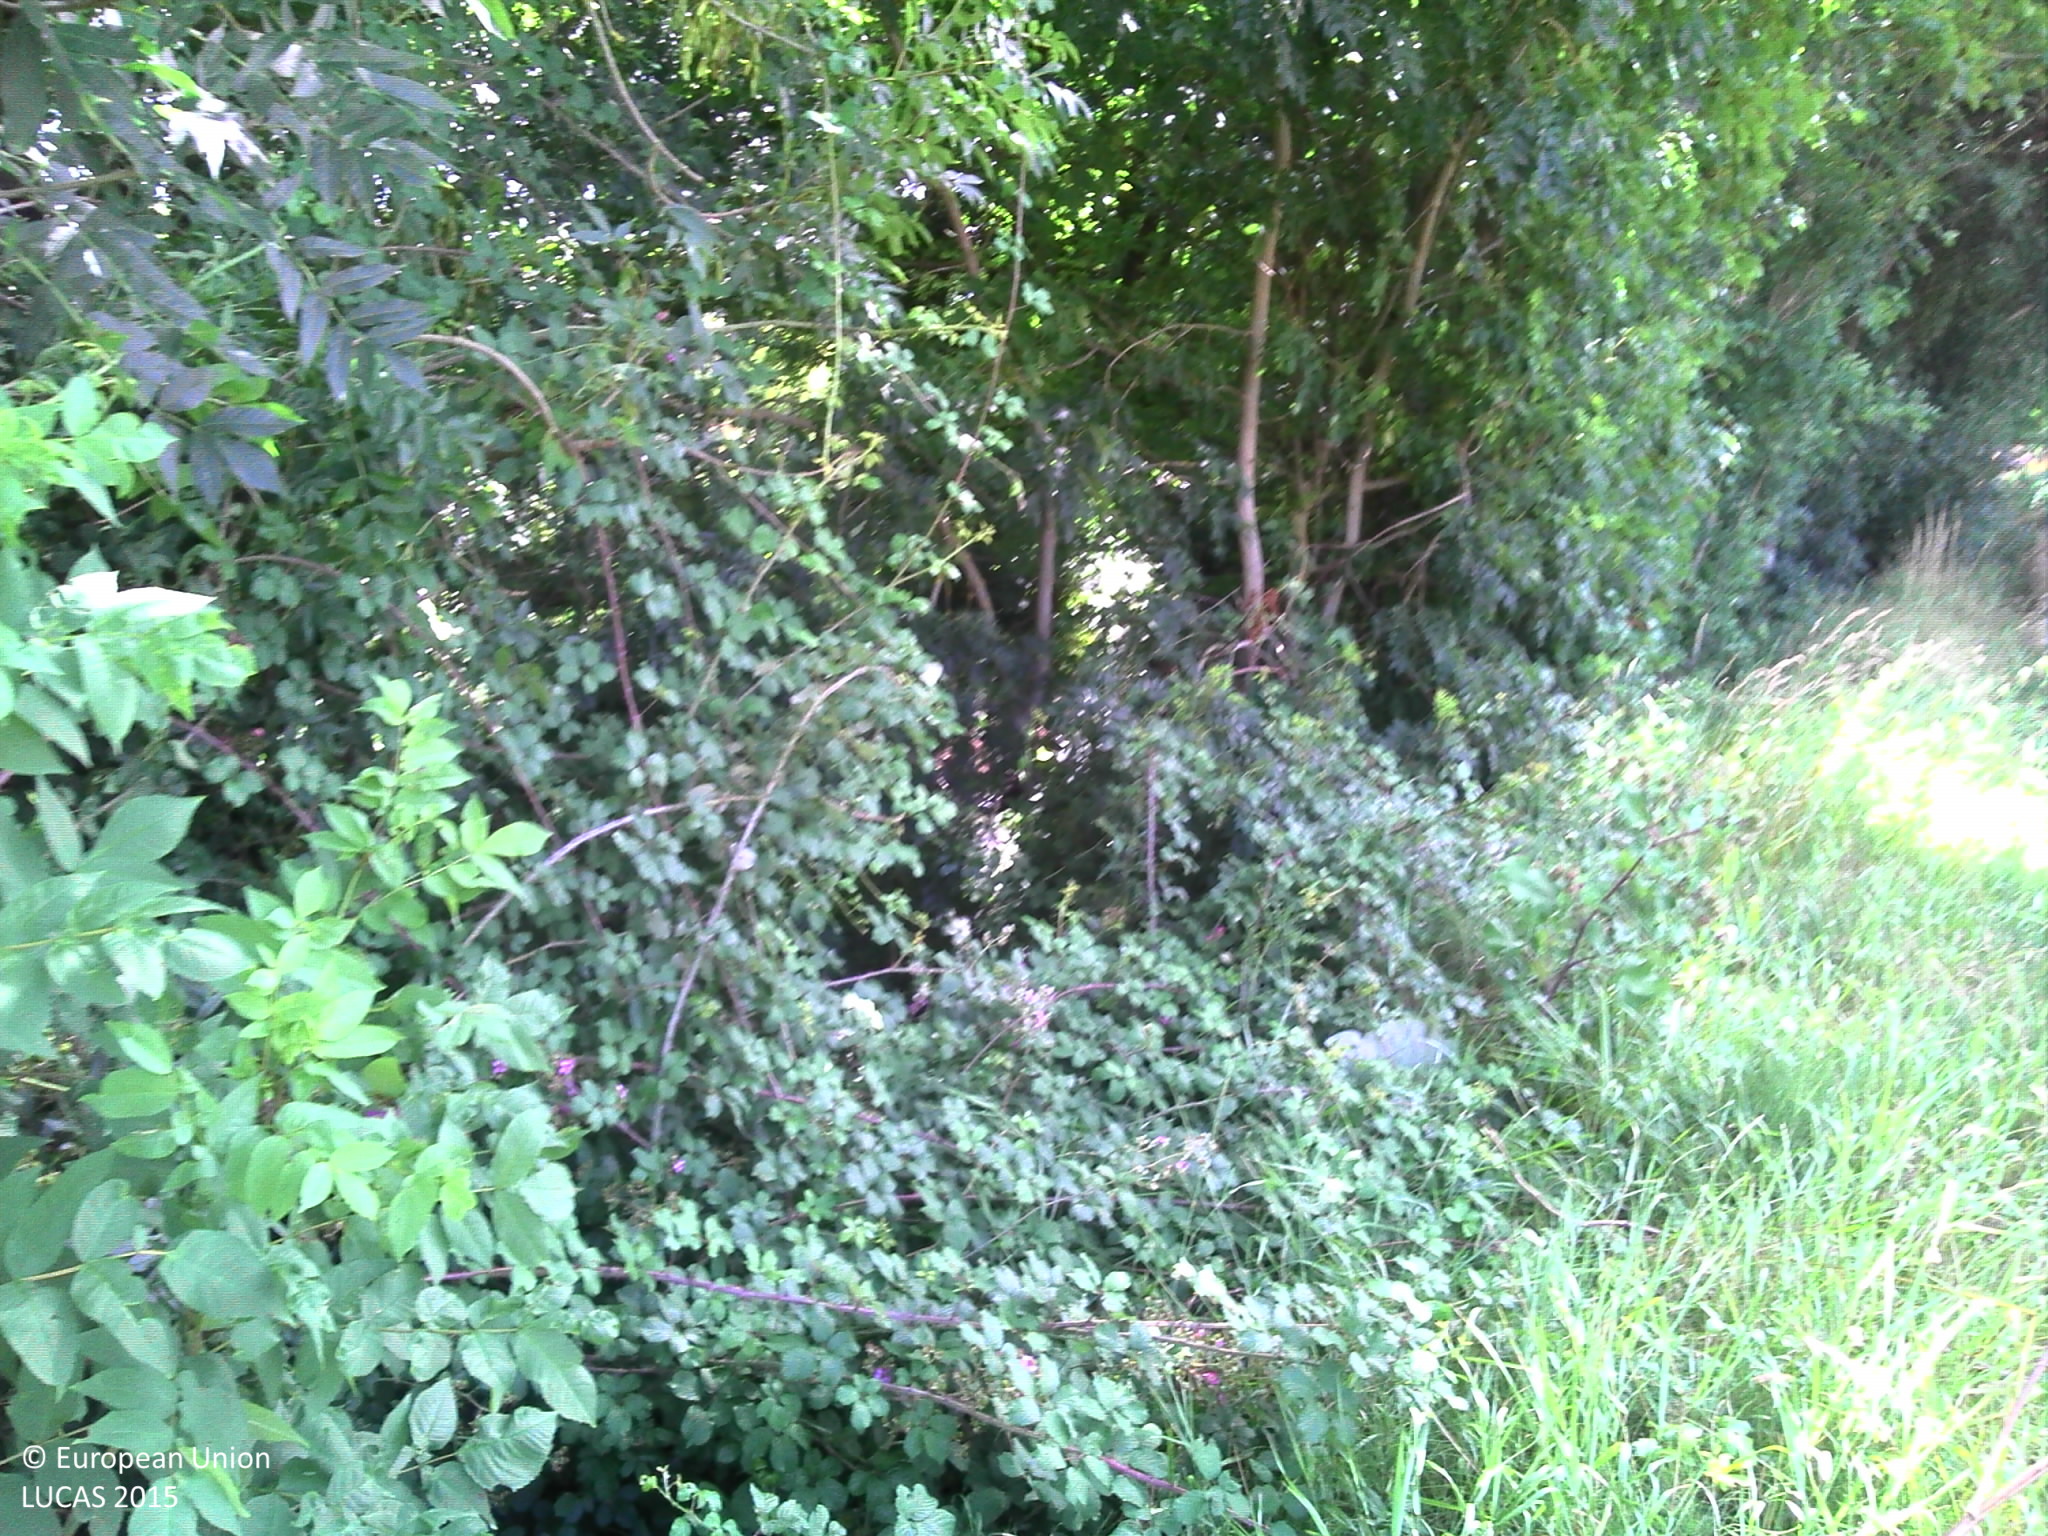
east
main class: Woodland
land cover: Broadleaved woodland
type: mesophytic deciduous forest
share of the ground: > 75 %
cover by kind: broadleaved forest trees 90 %, herbaceous plants 10 %
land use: Semi-natural and natural areas not in use
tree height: < 5 m
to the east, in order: Broadleaved woodland; Inland fresh water bodies; Broadleaved woodland; Fences; Grassland with sparse tree/shrub cover; Fences; Managed hedges; Artificial constructions in urban areas; Grassland without tree/shrub cover; Fences; Broadleaved woodland
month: July
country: FR
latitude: 48.9125
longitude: -0.1705
